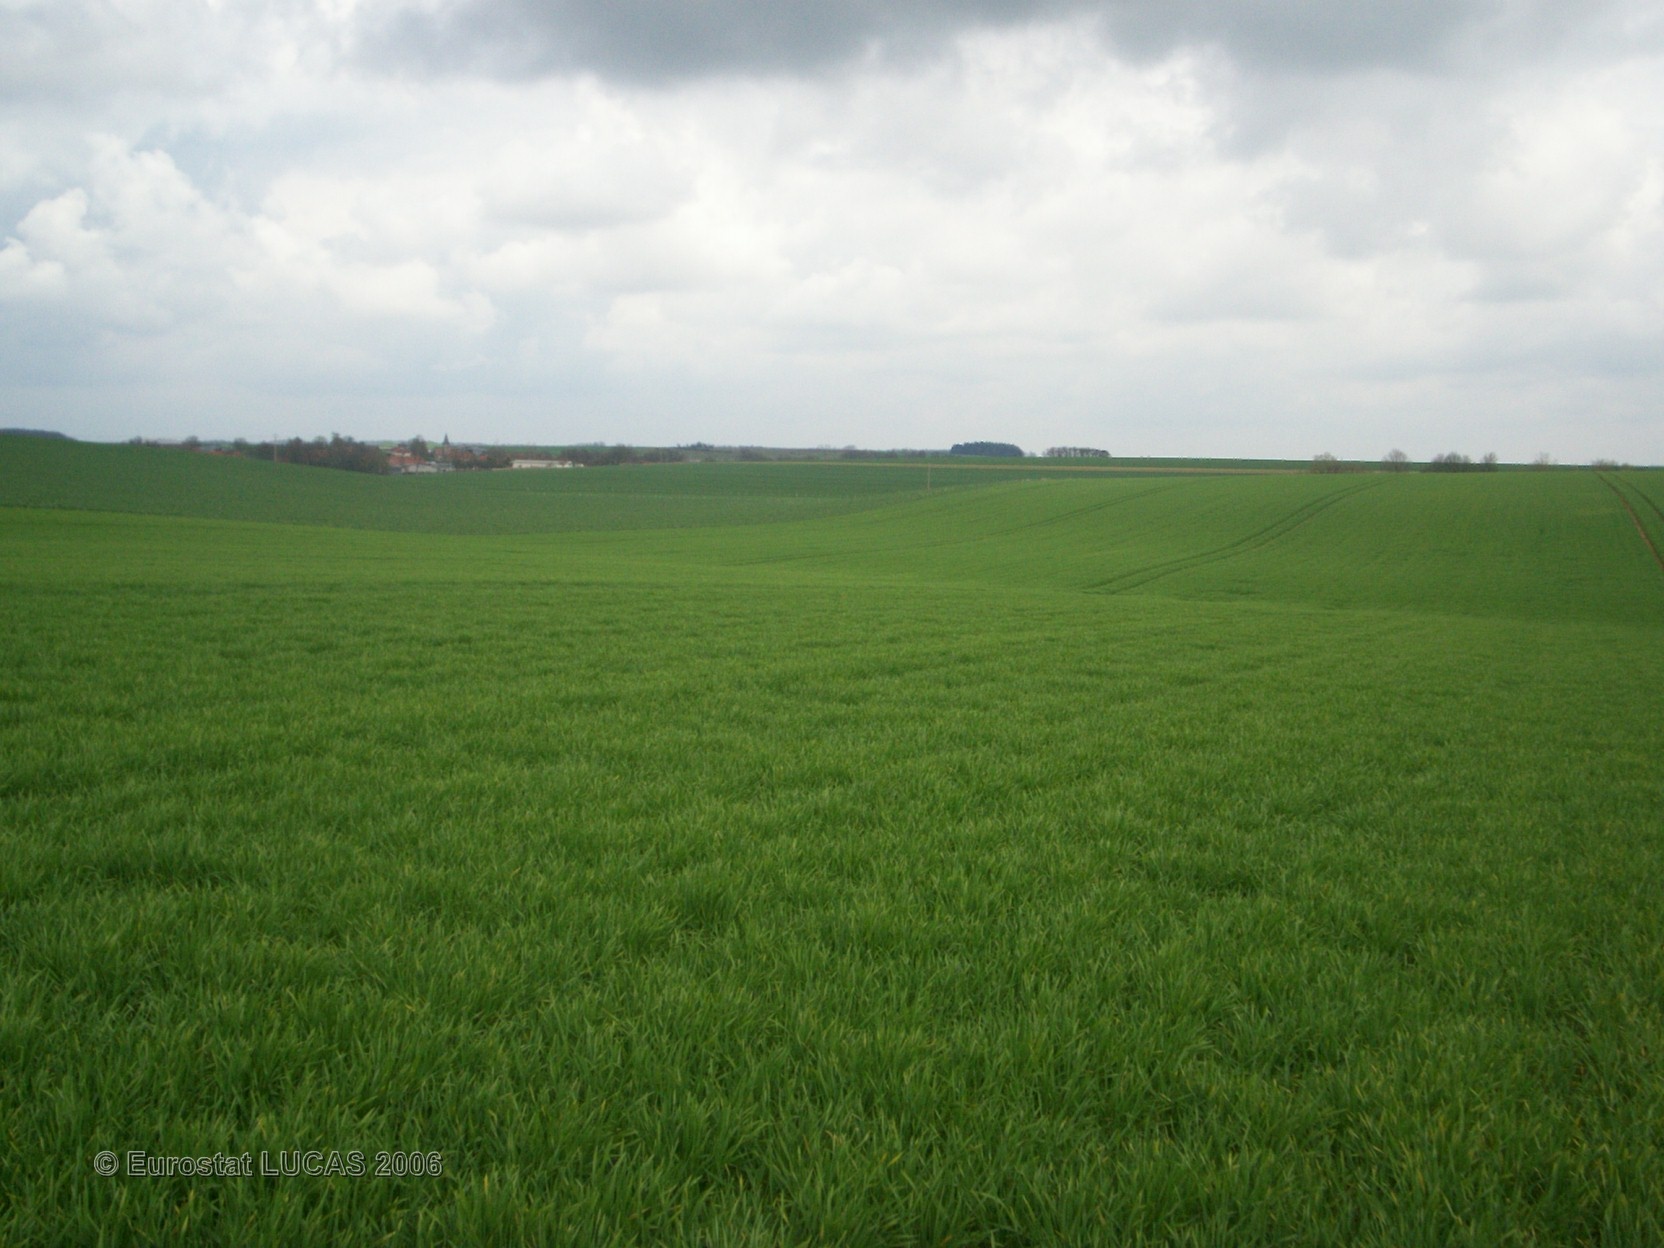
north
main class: Cropland
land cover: Barley
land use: Agriculture (excluding fallow land and kitchen gardens)
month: April
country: FR
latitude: 48.9460
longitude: 5.1511
